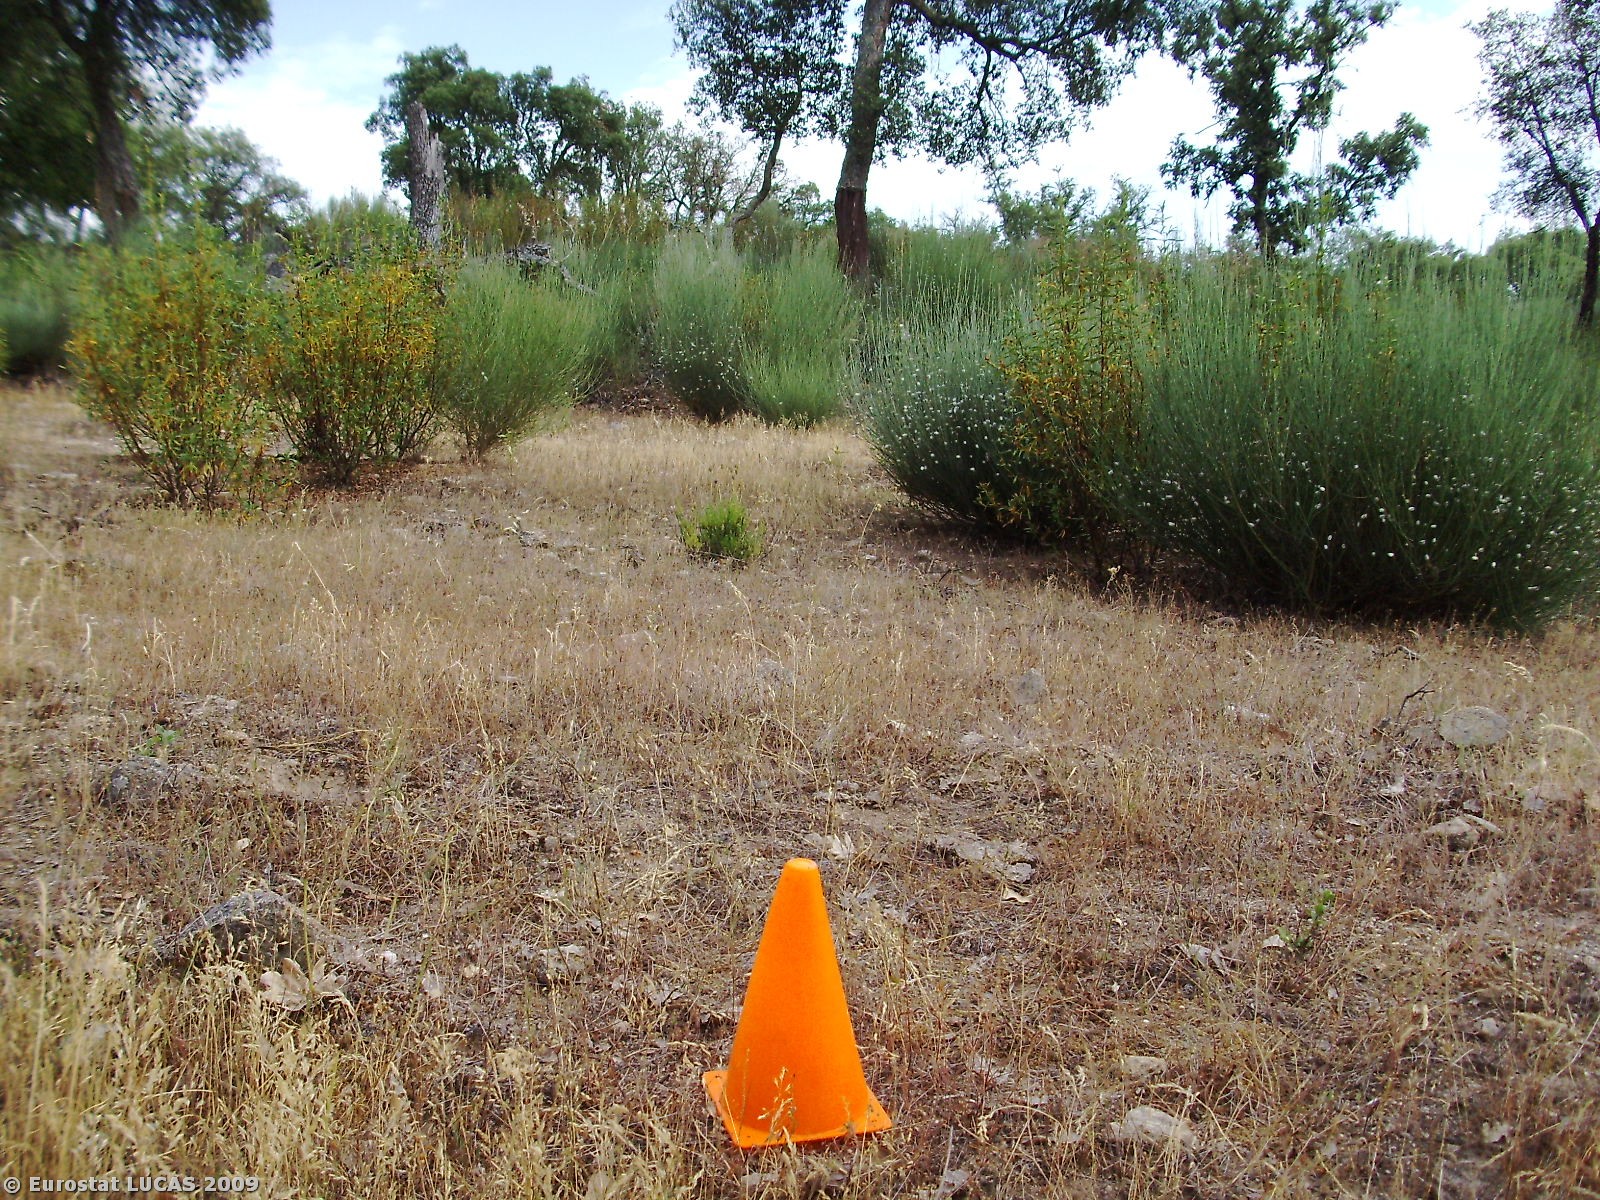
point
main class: Woodland
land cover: Broadleaved woodland
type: broadleaved evergreen forest
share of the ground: 25 - 50 %
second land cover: Spontaneously vegetated surfaces
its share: 50 - 75 %
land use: Forestry
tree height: > 5 m
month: June
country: PT
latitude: 39.3833
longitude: -7.4937
